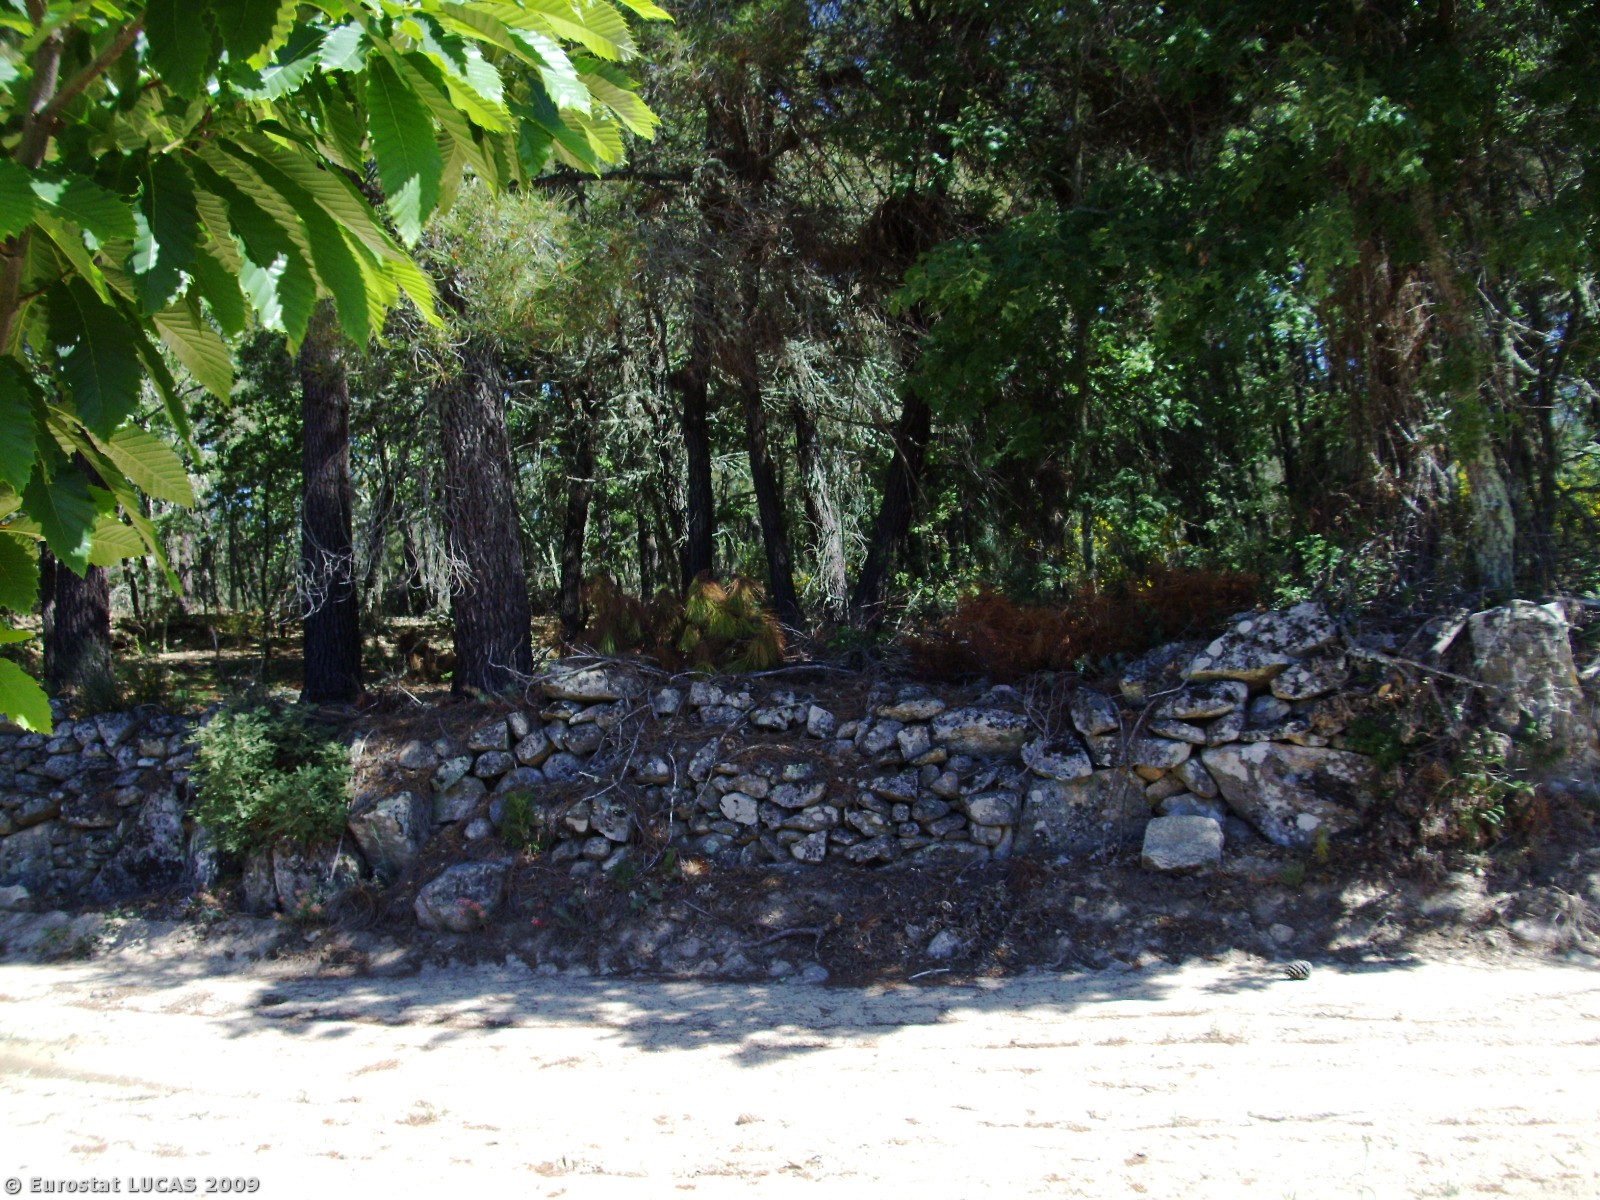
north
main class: Cropland
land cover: Nuts trees
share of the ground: 25 - 50 %
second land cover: Spontaneously vegetated surfaces
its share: 25 - 50 %
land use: Agriculture (excluding fallow land and kitchen gardens)
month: May
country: PT
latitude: 40.9590
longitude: -7.4520
